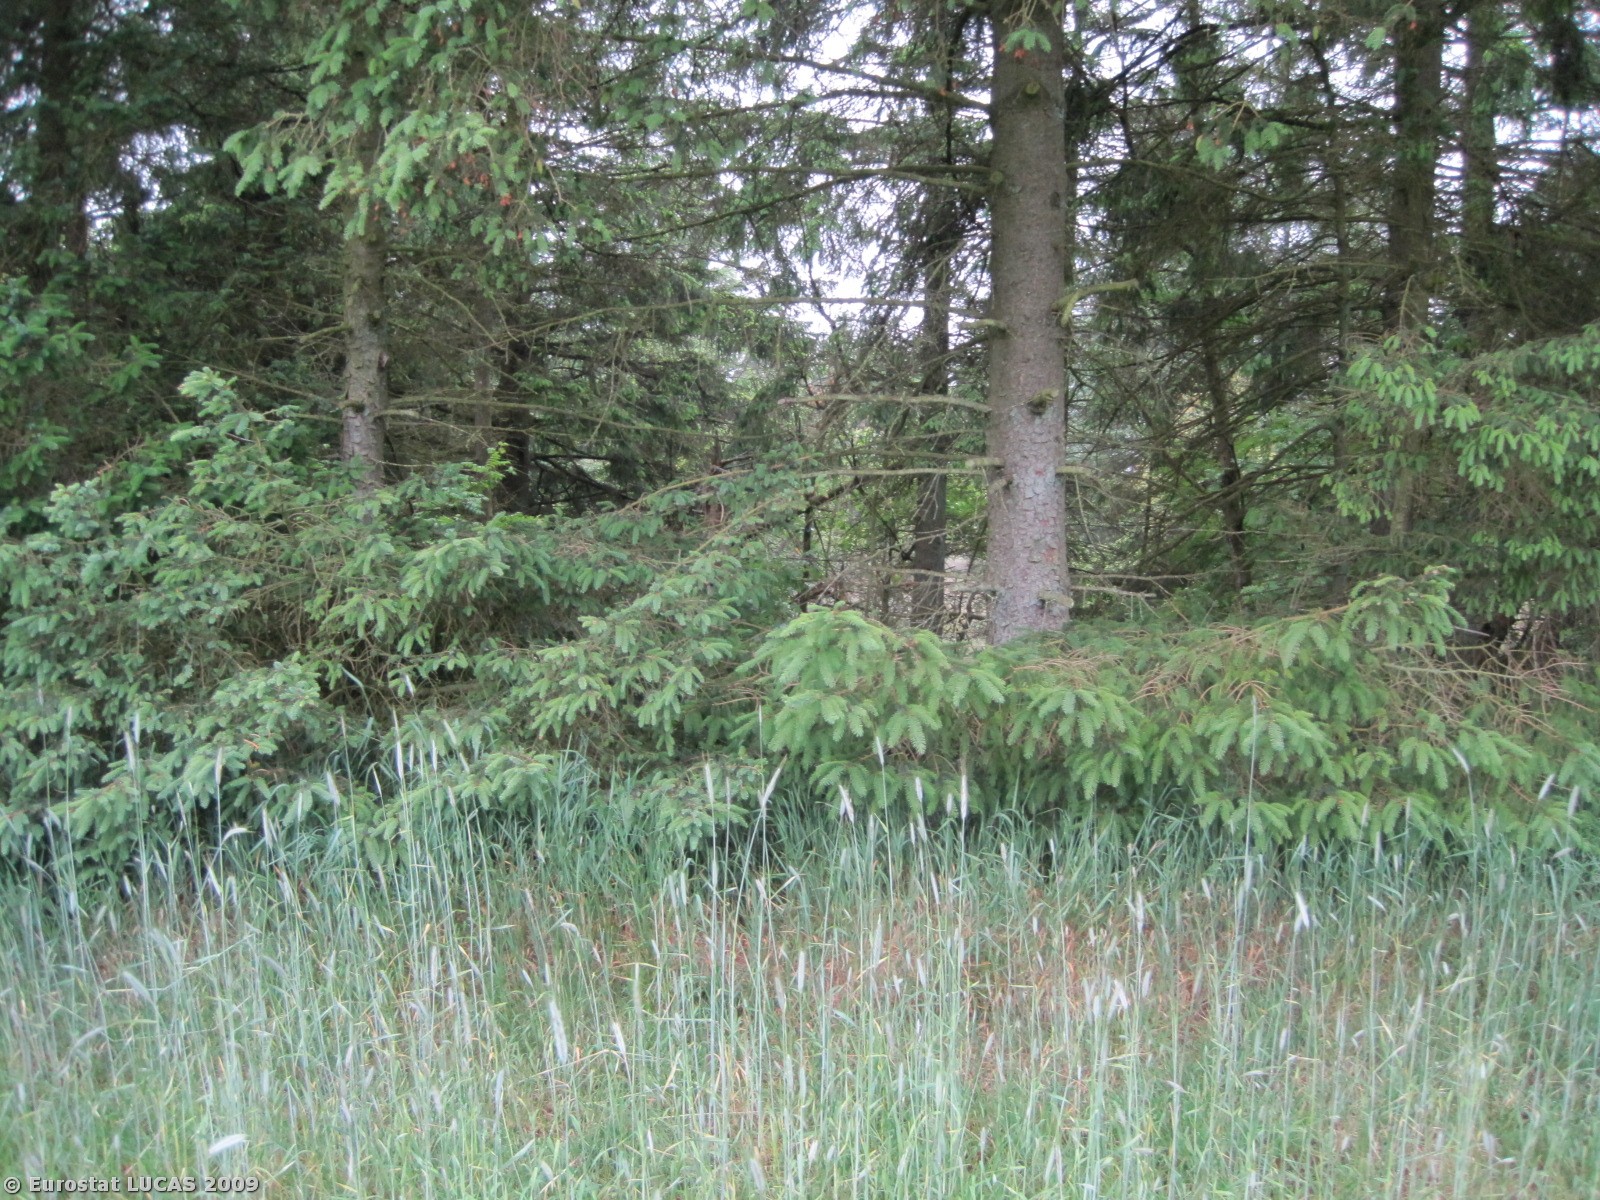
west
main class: Grassland
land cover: Grassland without tree/shrub cover
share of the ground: > 75 %
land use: Agriculture (excluding fallow land and kitchen gardens)
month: June
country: DK
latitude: 57.4641
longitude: 10.1498
